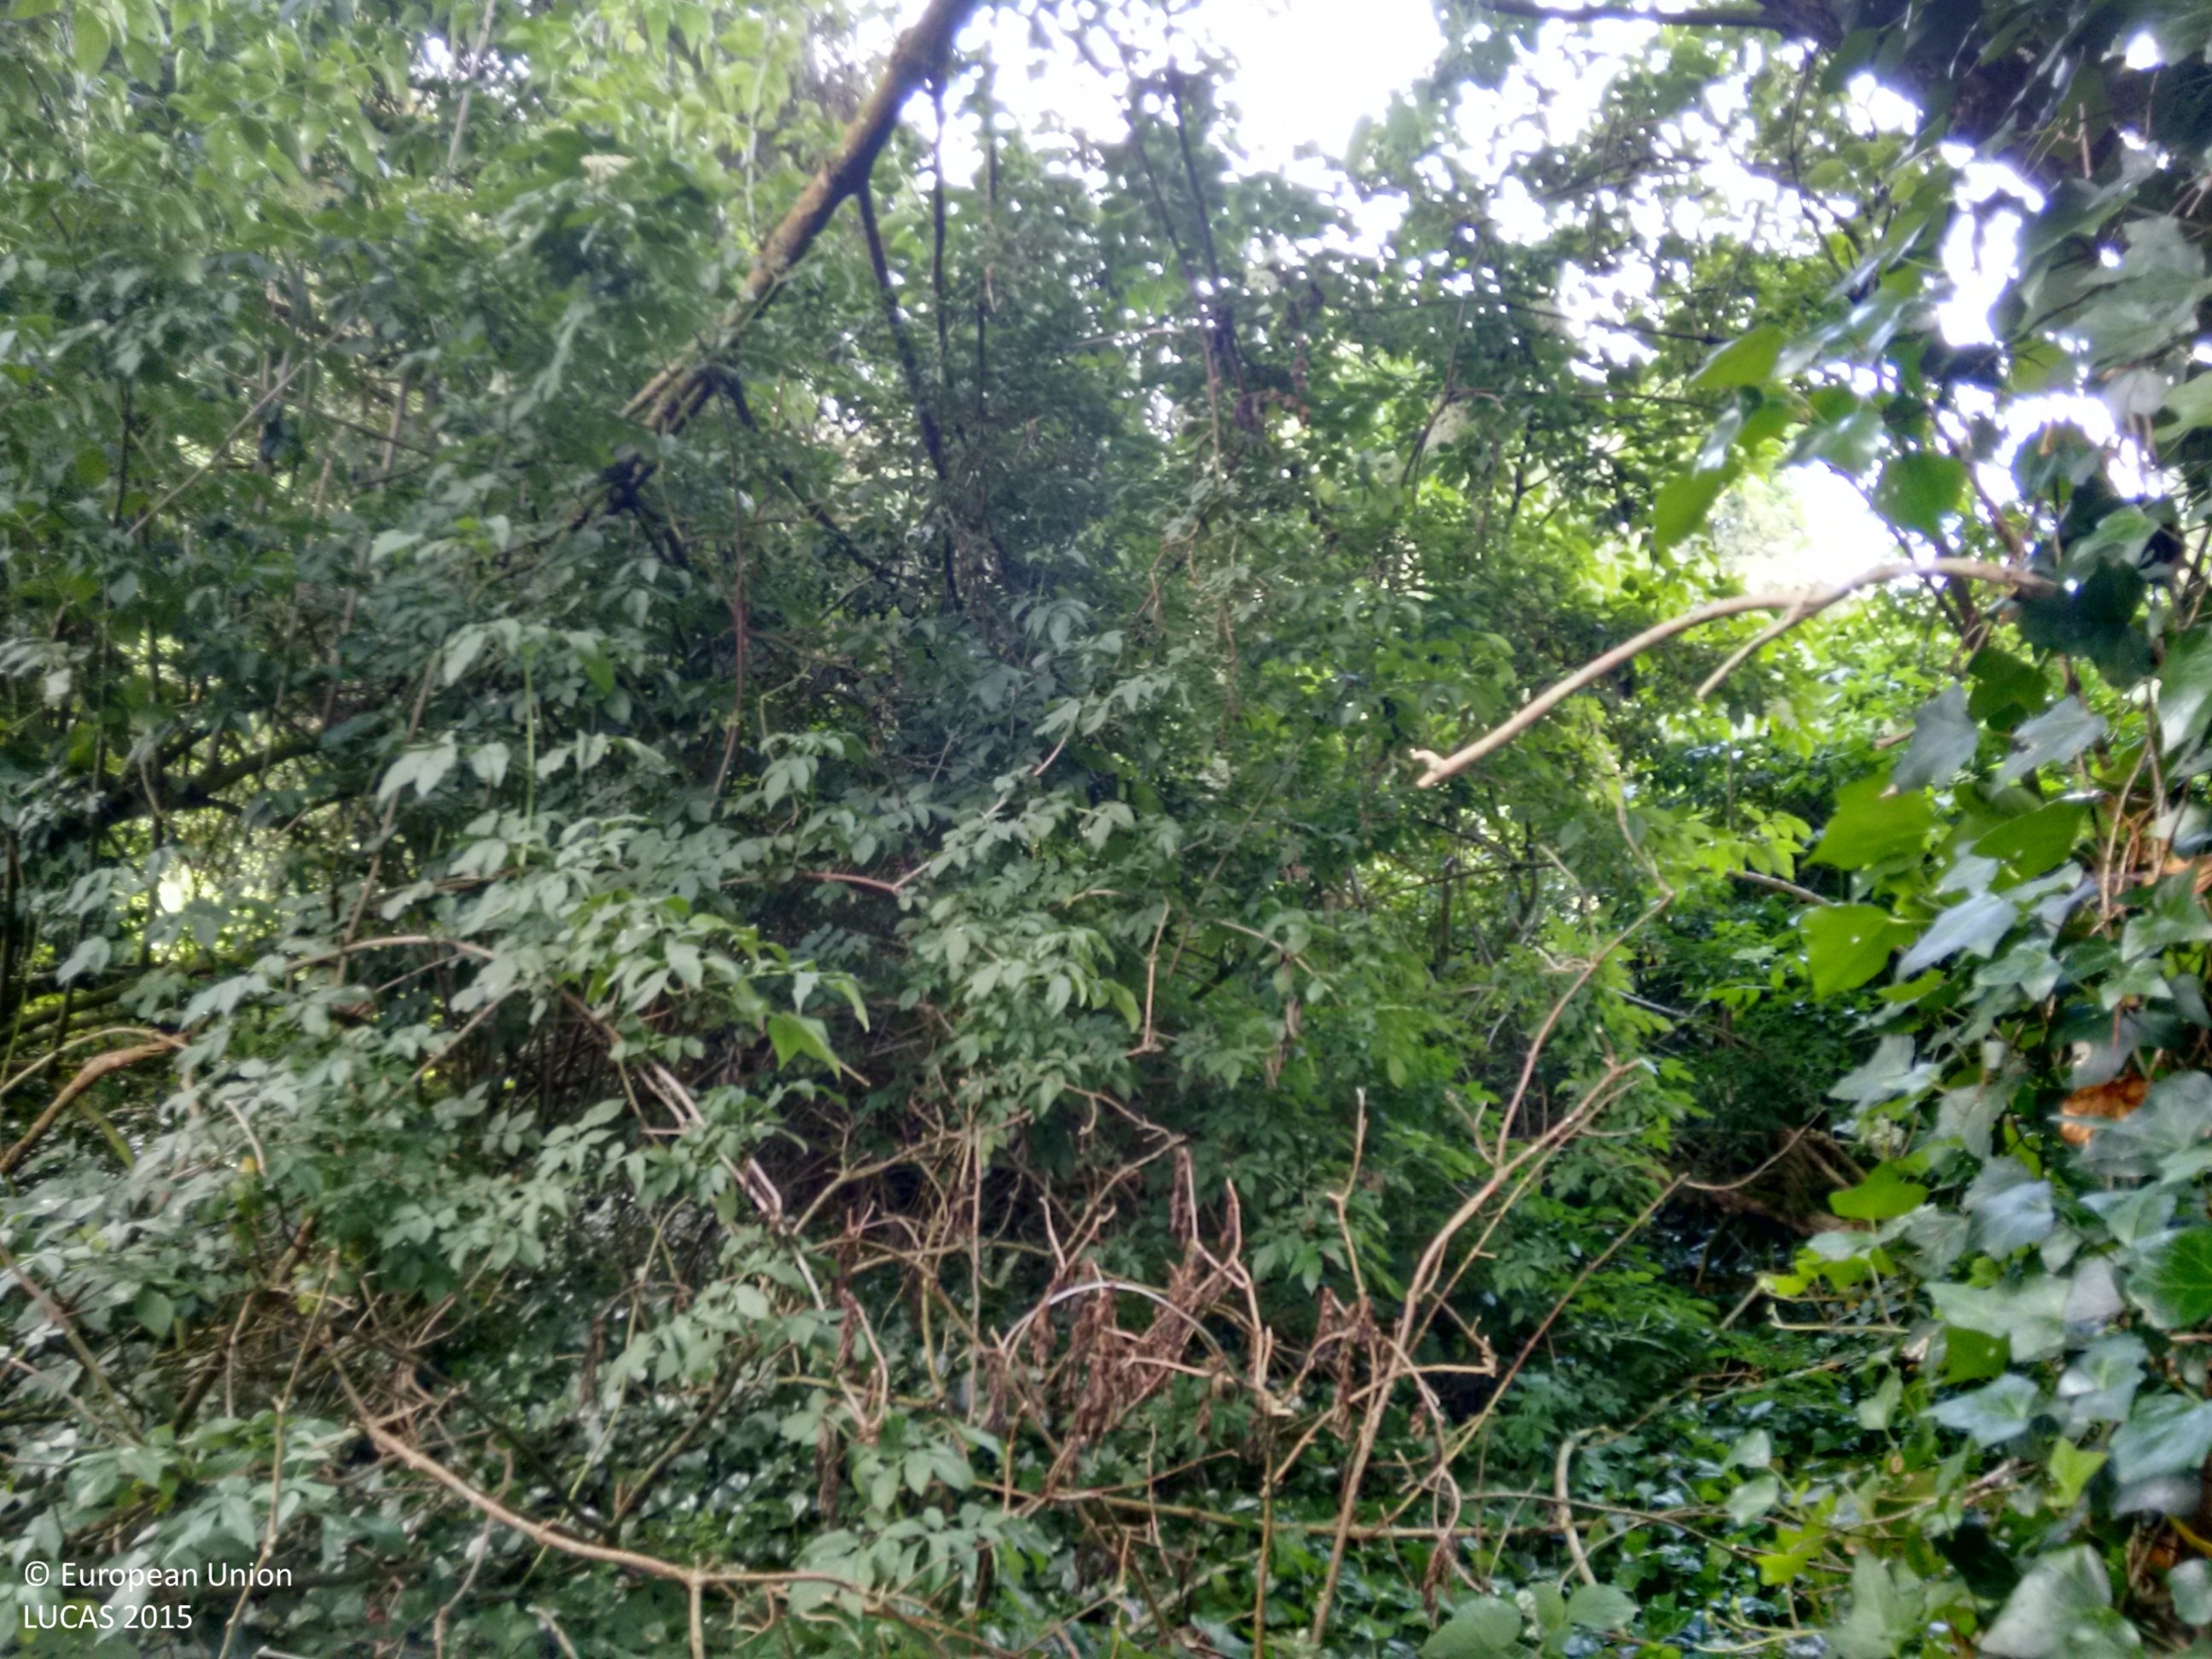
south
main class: Woodland
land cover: Broadleaved woodland
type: mesophytic deciduous forest
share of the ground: > 75 %
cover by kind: broadleaved forest trees 60 %, coniferous forest trees 20 %, shrubs 20 %
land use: Semi-natural and natural areas not in use
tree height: > 5 m
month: June
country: IE
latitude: 53.6987
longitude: -6.7181
